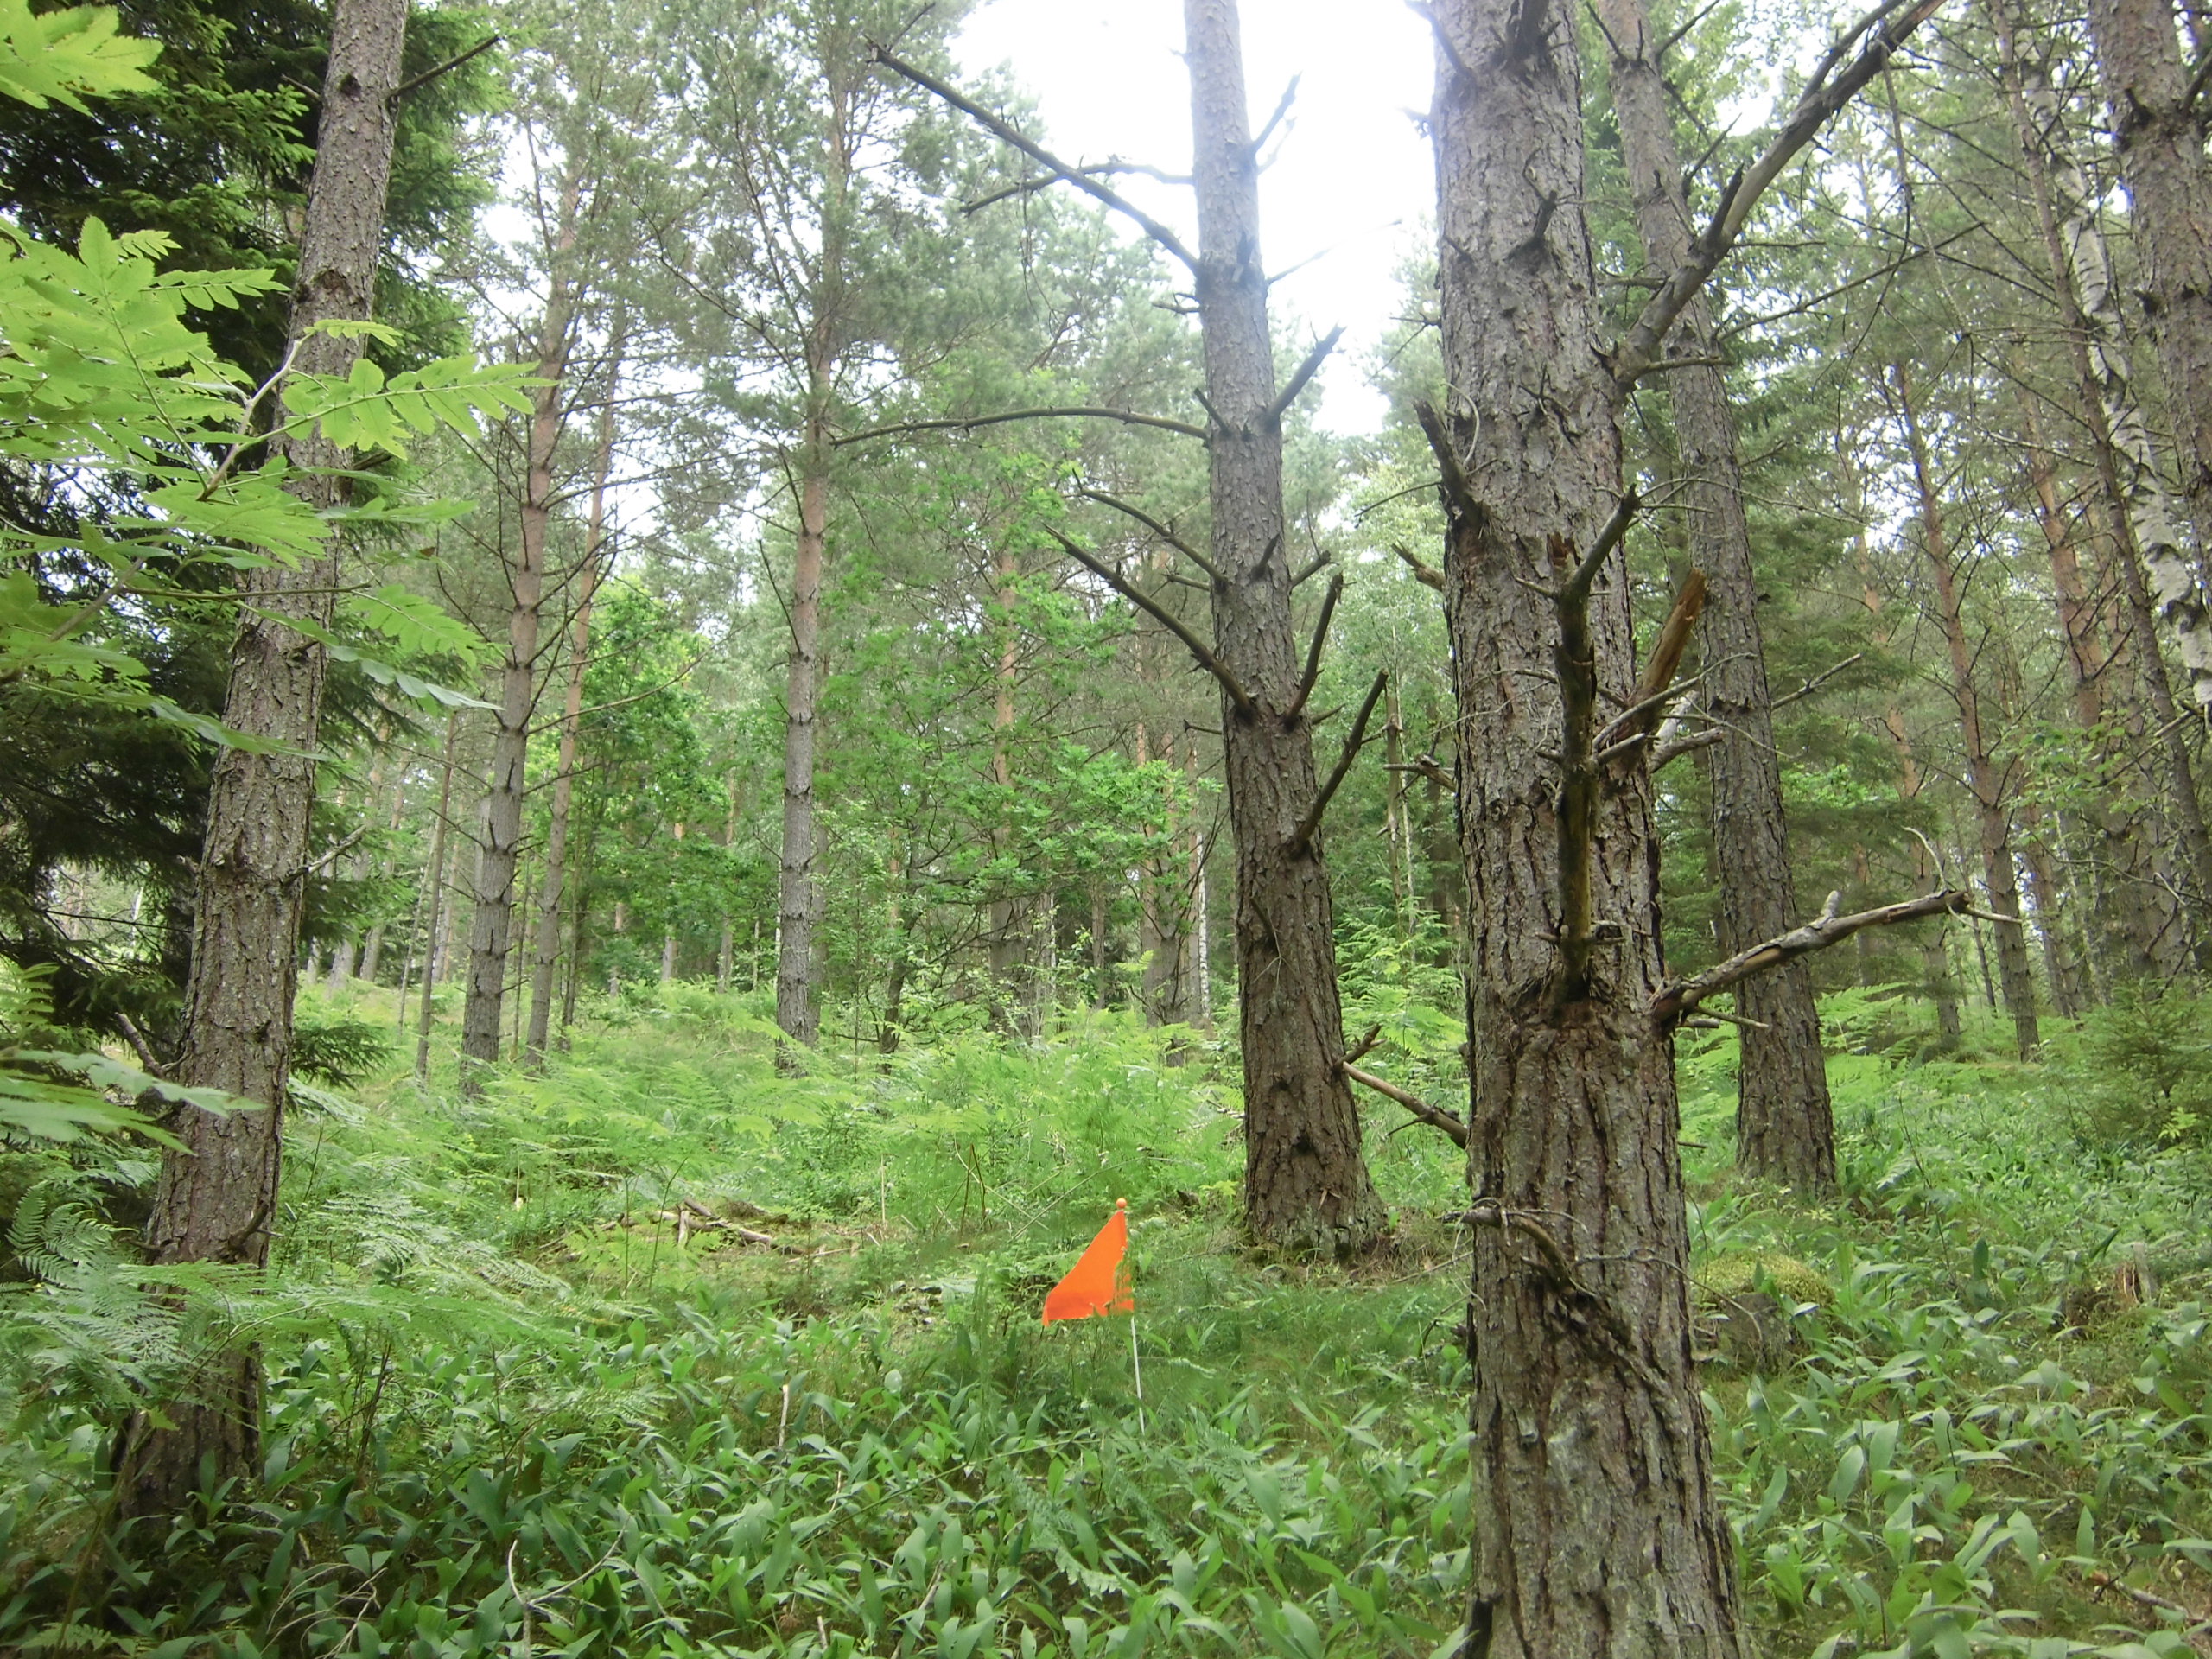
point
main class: Woodland
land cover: Pine dominated coniferous woodland
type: boreal forest
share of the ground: 50 - 75 %
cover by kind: coniferous forest trees 55 %, herbaceous plants 30 %, broadleaved forest trees 5 %, shrubs 5 %, lichens and mosses 5 %
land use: Forestry
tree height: > 5 m
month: July
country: SE
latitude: 57.3721
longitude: 14.9351
